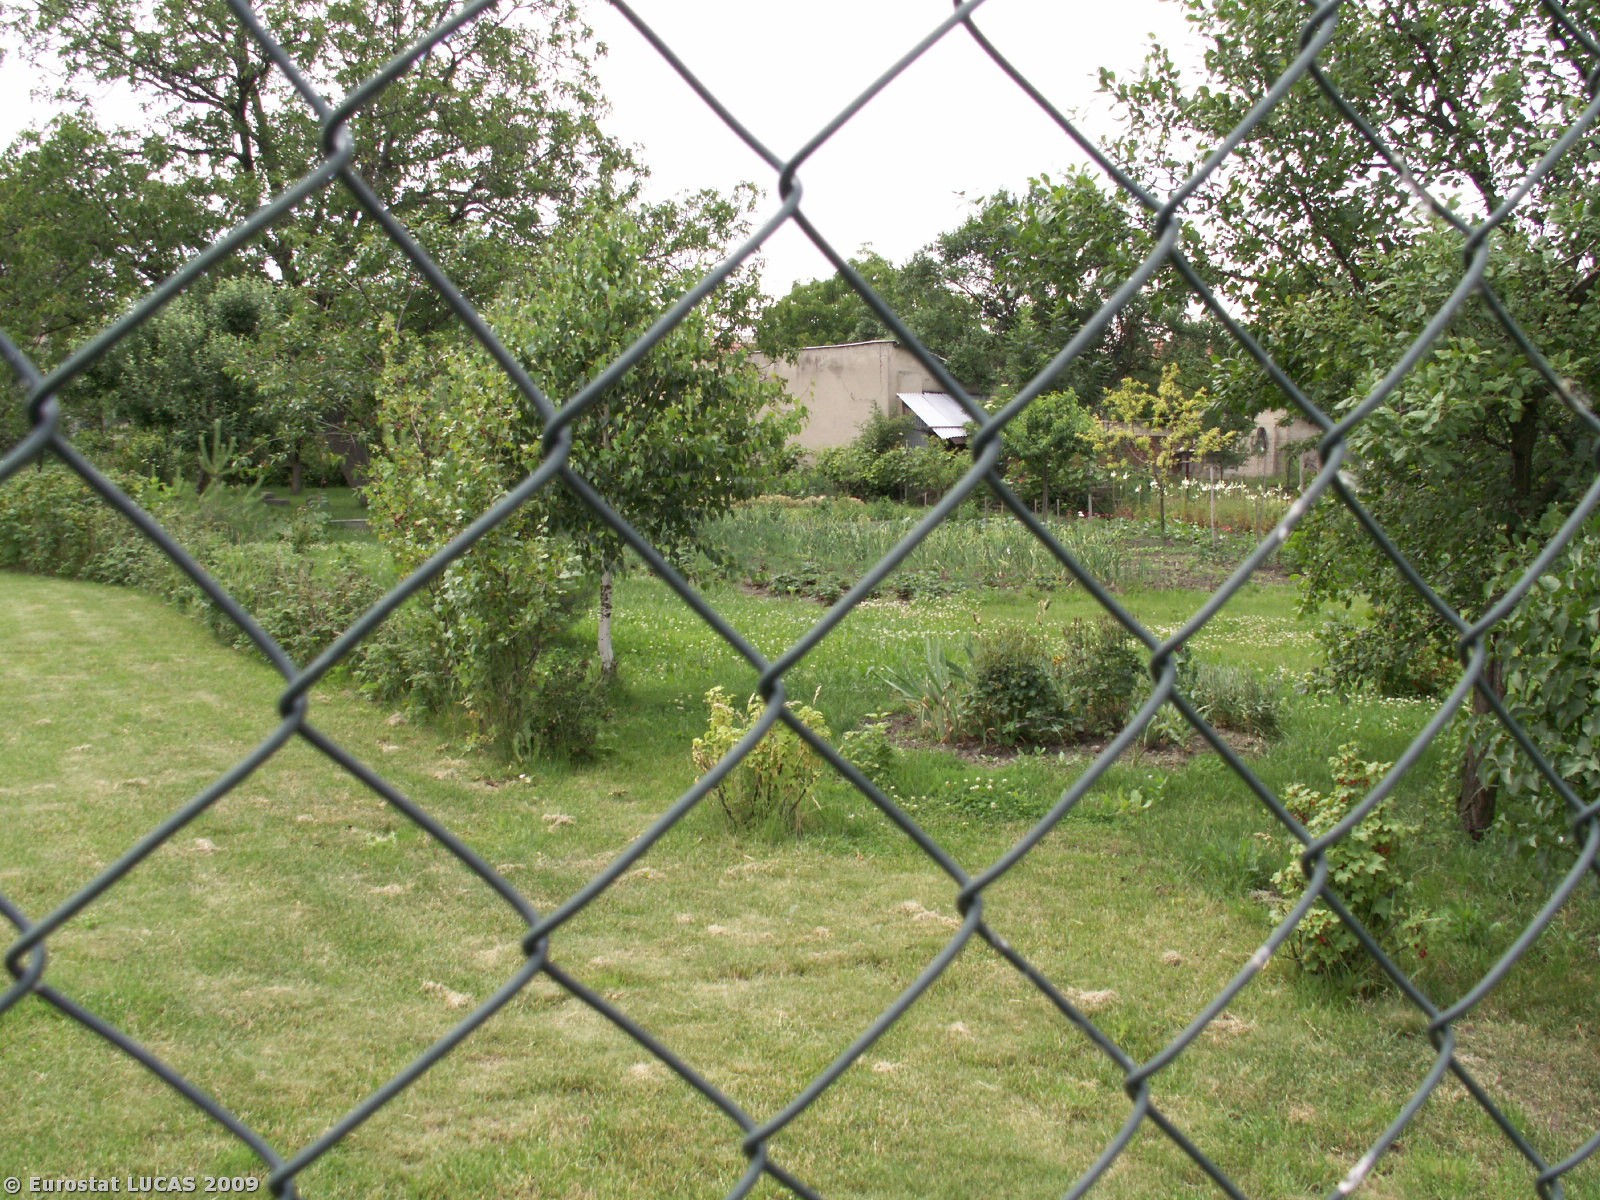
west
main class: Grassland
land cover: Grassland with sparse tree/shrub cover
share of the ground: > 75 %
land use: Residential
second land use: Amenities, museums, leisure
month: June
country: CZ
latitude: 48.8806
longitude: 17.3605
